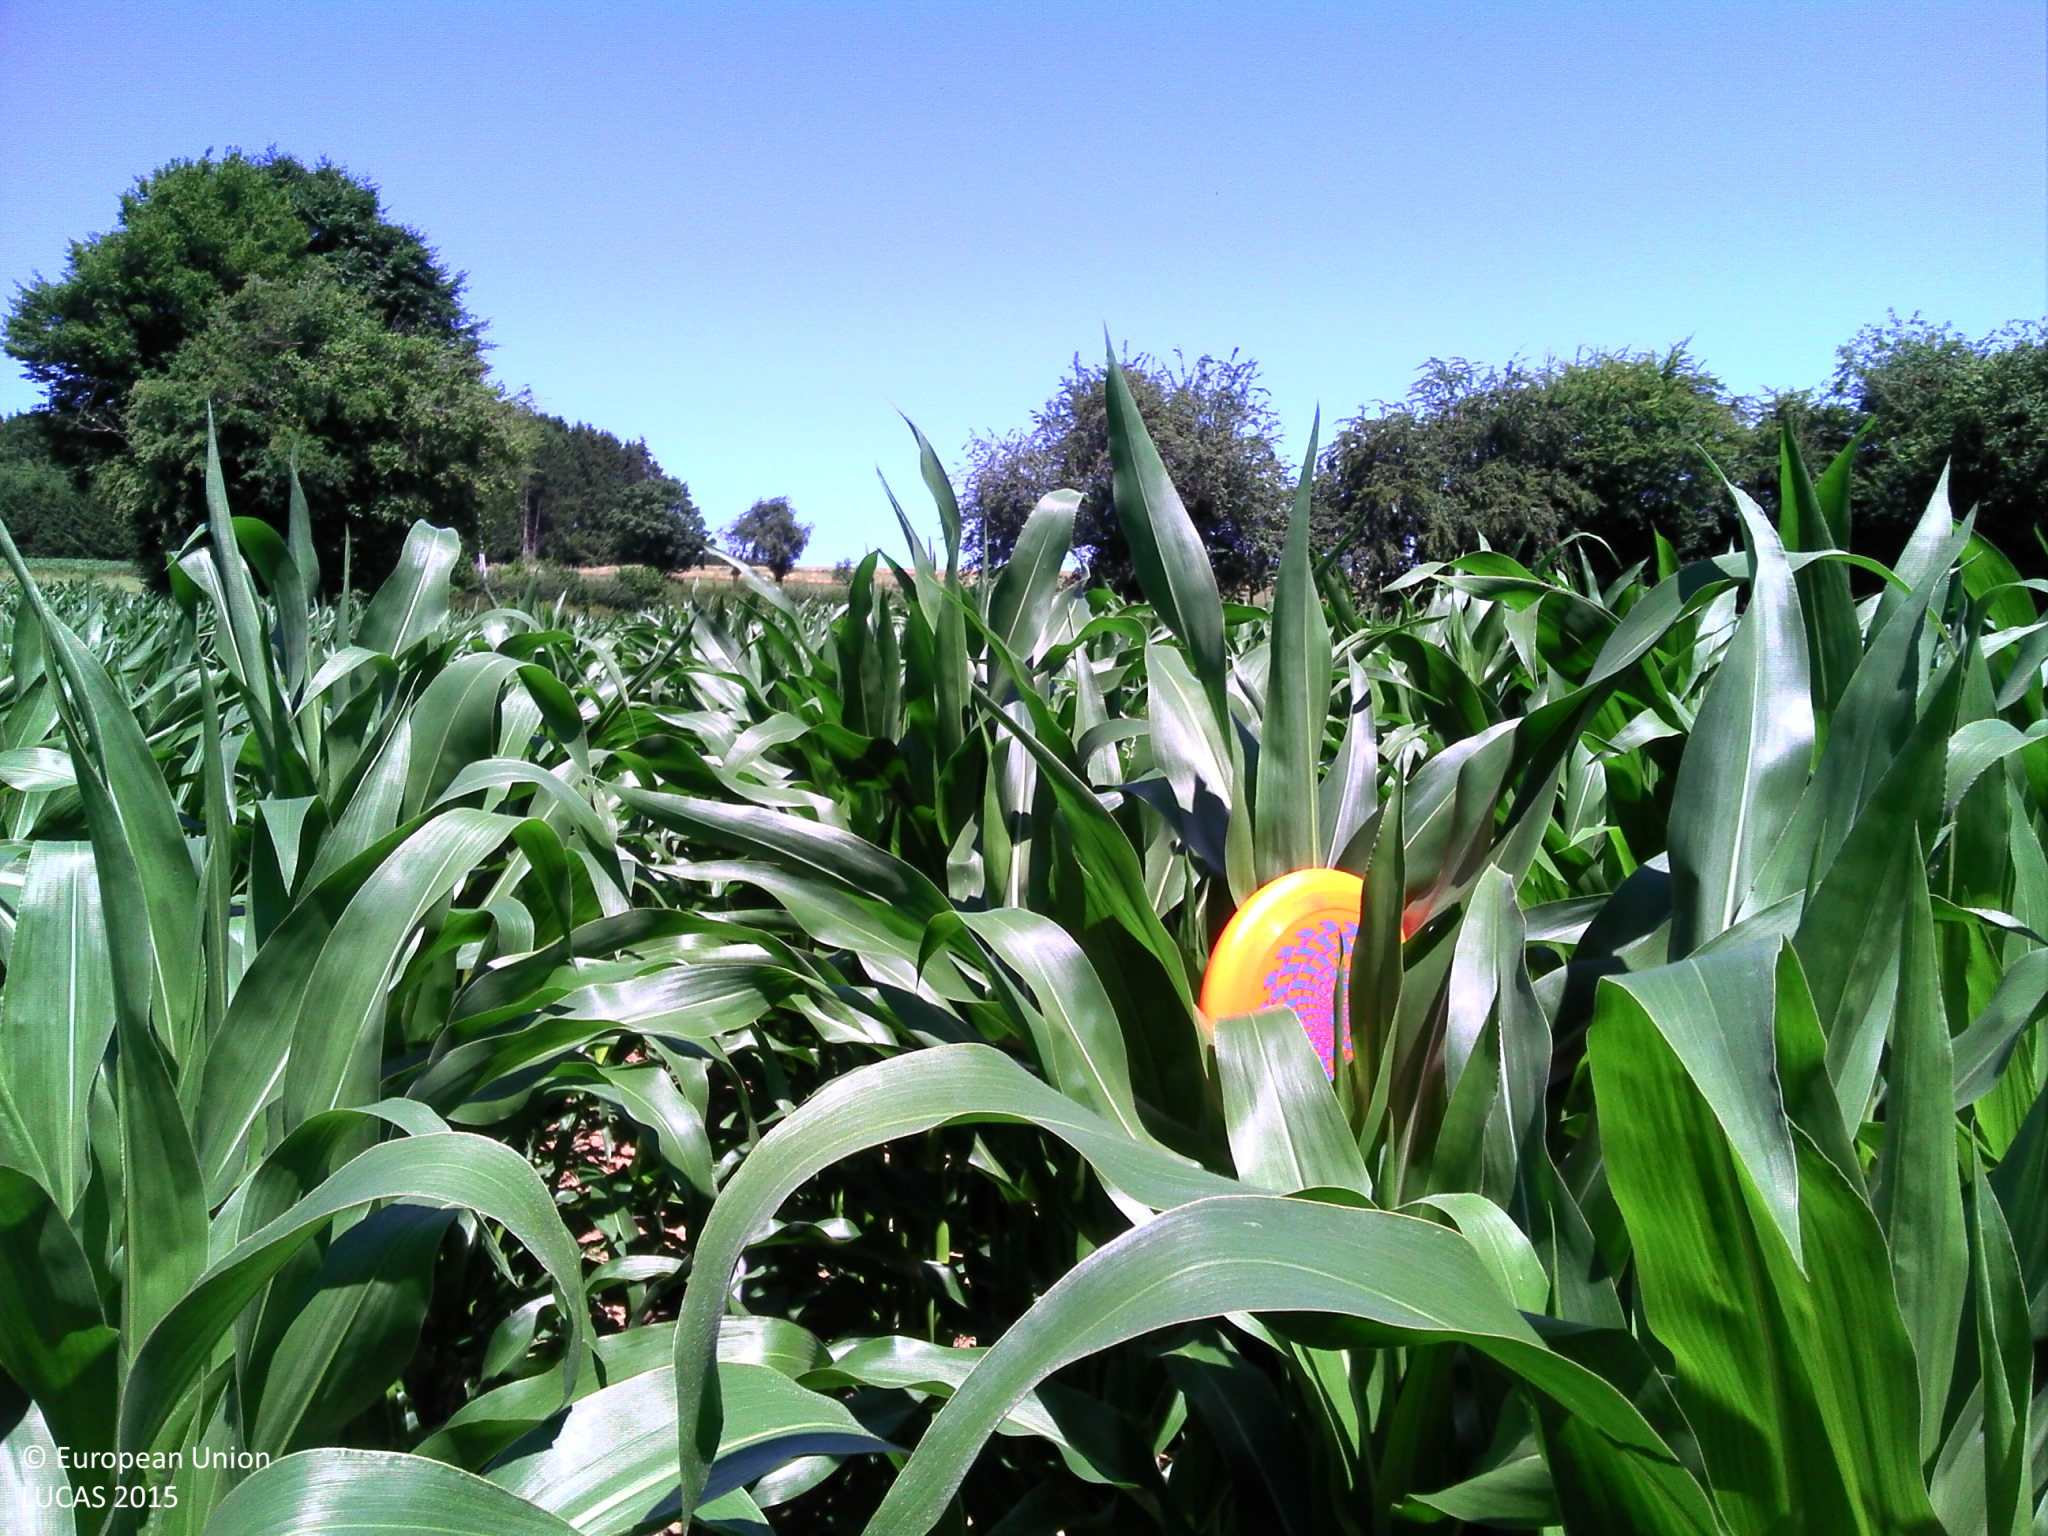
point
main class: Cropland
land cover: Maize
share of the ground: > 75 %
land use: Agriculture (excluding fallow land and kitchen gardens)
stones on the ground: < 10 %
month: July
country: BE
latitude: 50.1160
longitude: 5.5652
